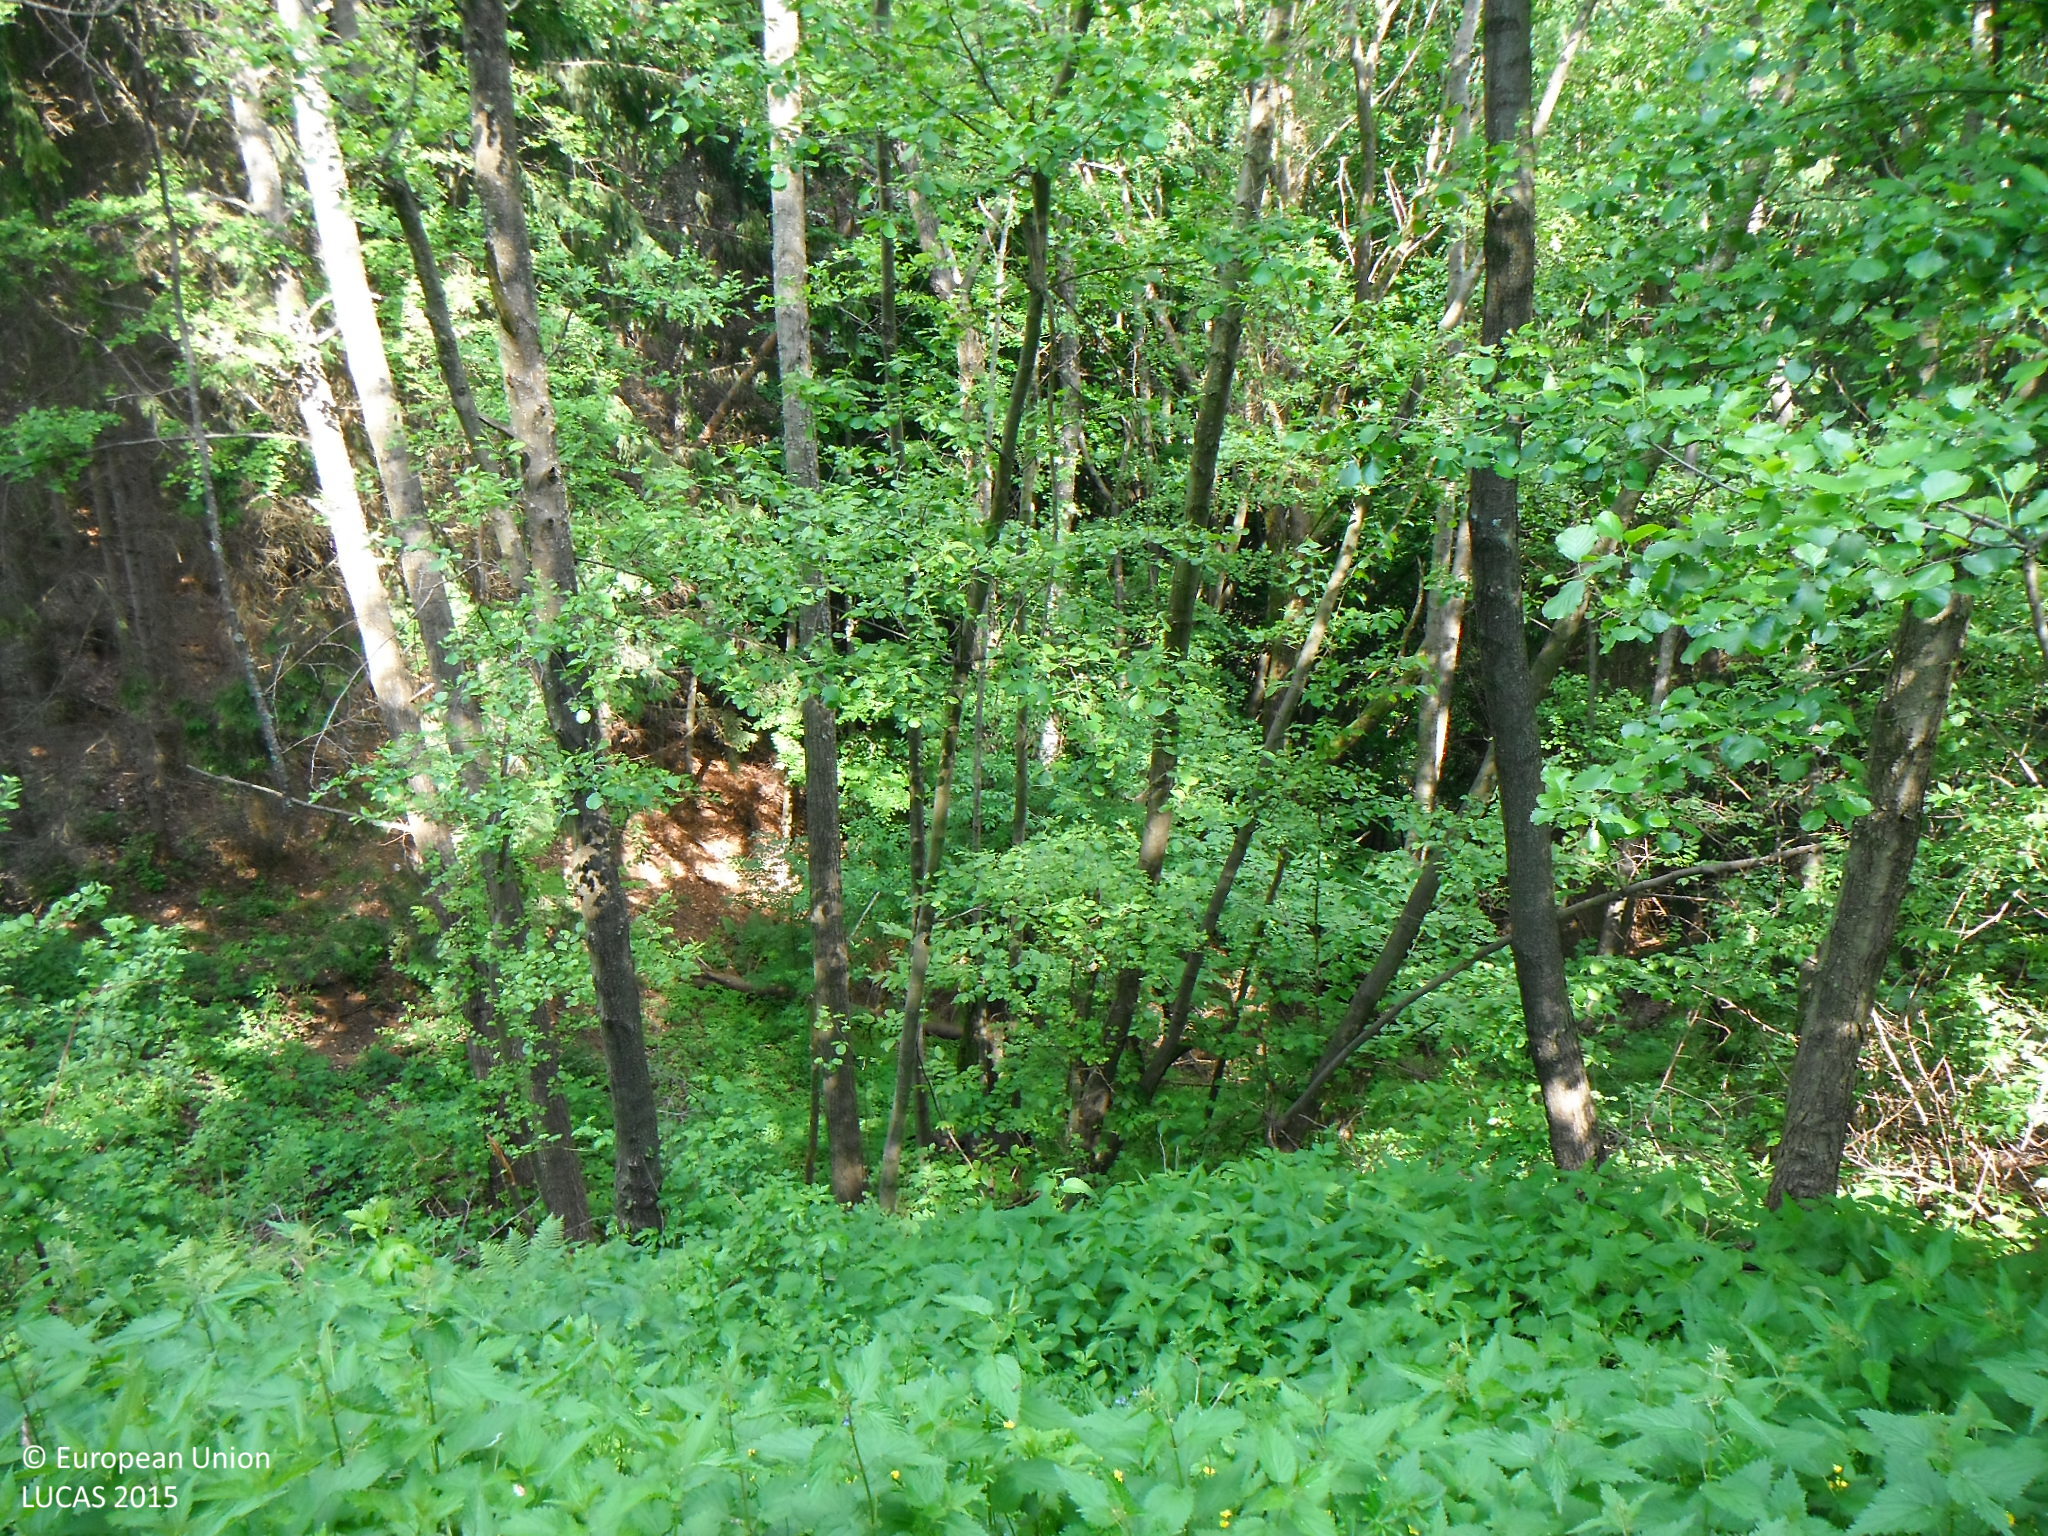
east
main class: Woodland
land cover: Broadleaved woodland
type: mesophytic deciduous forest
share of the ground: > 75 %
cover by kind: broadleaved forest trees 80 %, herbaceous plants 20 %
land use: Forestry
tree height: > 5 m
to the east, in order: Broadleaved woodland; Spruce dominated coniferous woodland; Tracks; Rivers and streams; Broadleaved woodland; Spruce dominated mixed woodland
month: May
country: SK
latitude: 48.5331
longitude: 19.5457
